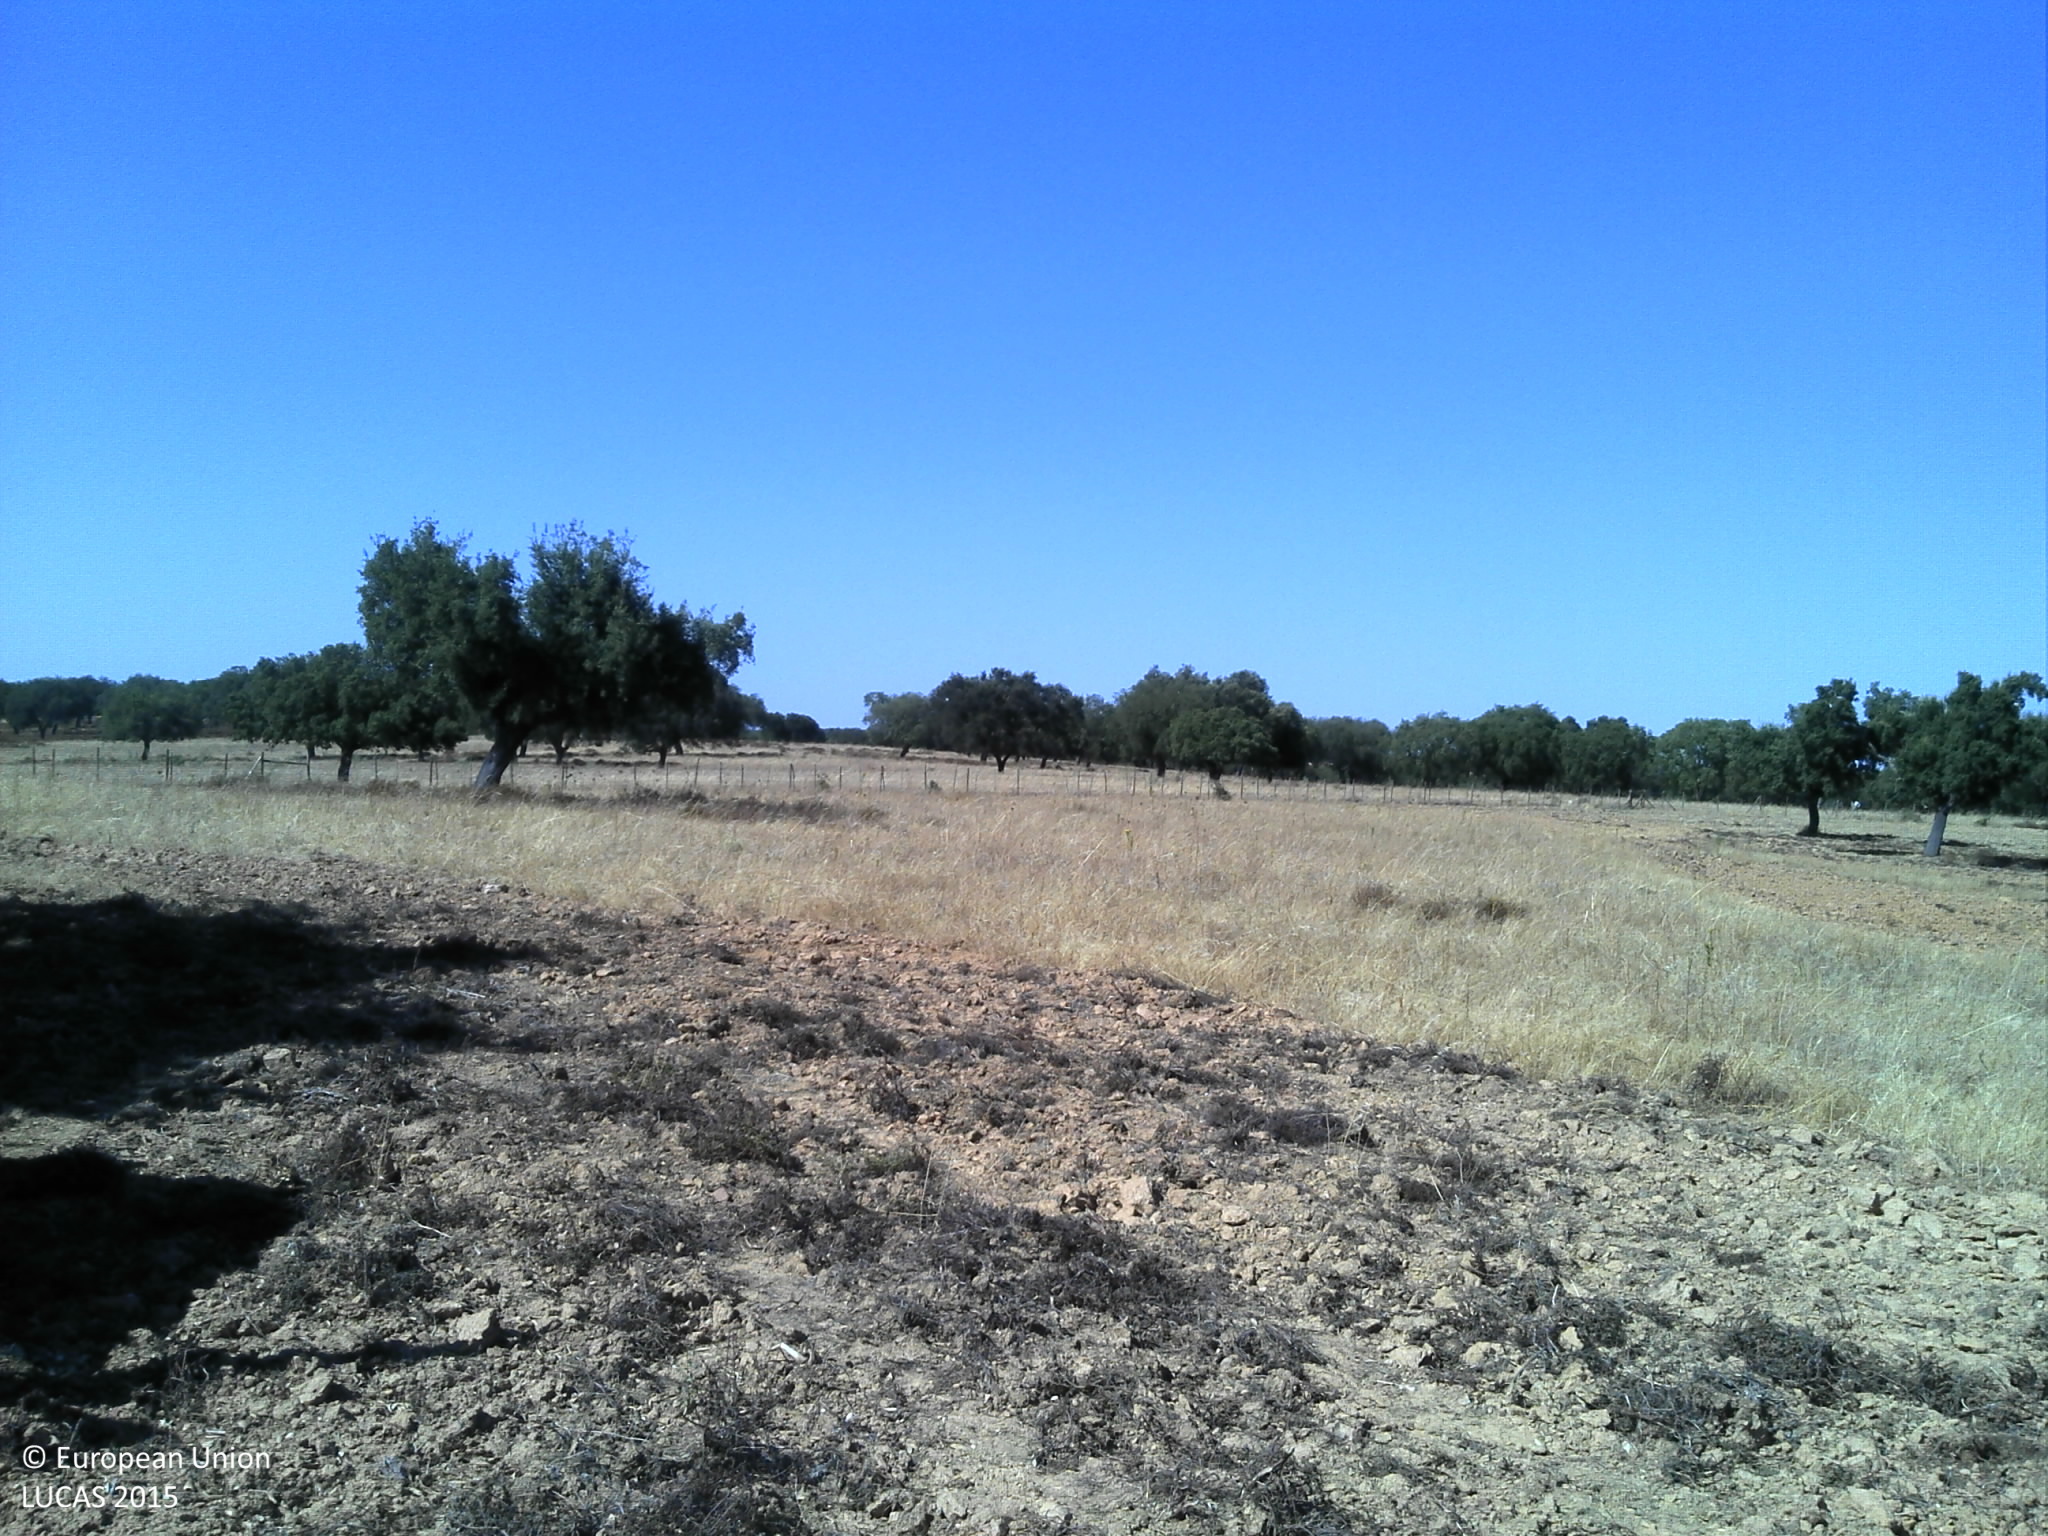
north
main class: Woodland
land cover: Broadleaved woodland
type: broadleaved evergreen forest
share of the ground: 10 - 25 %
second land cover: Grassland without tree/shrub cover
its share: < 10 %
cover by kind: unconsolidated bare surface 75 %, broadleaved forest trees 15 %, herbaceous plants 10 %
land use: Forestry
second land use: Agriculture (excluding fallow land and kitchen gardens)
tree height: > 5 m
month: July
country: PT
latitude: 38.8867
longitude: -7.3831
